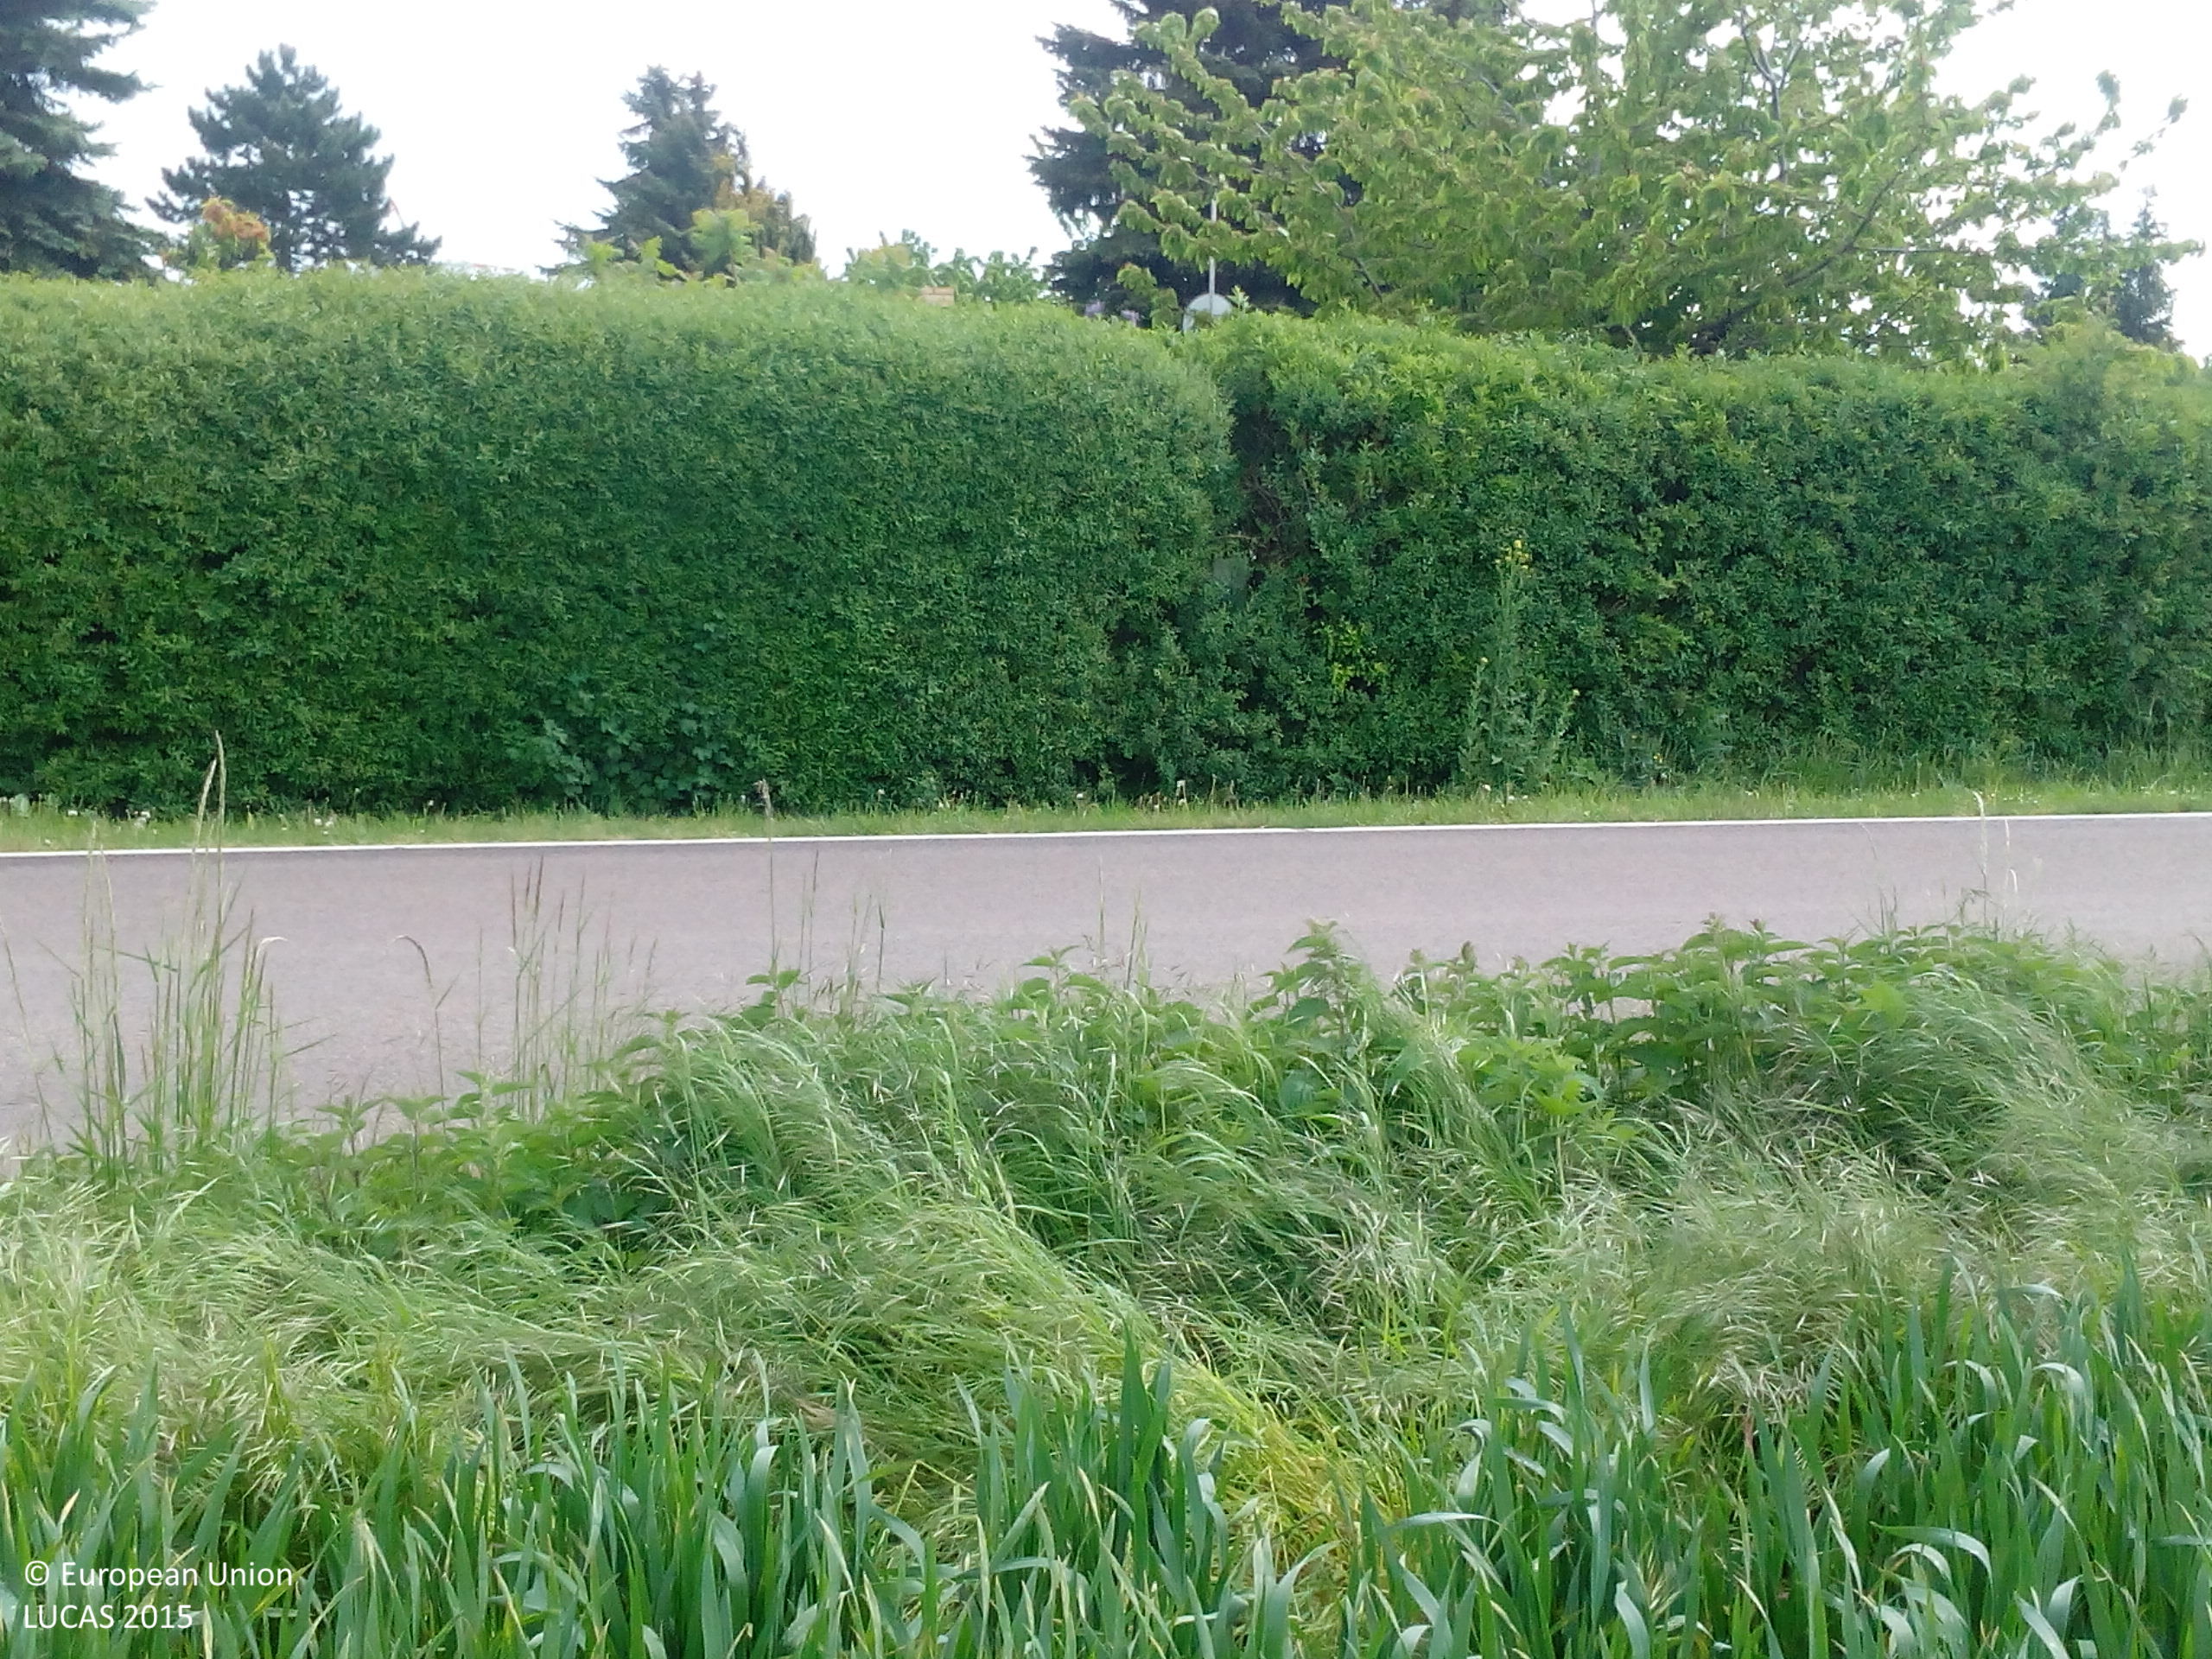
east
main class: Cropland
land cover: Common wheat
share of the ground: > 75 %
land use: Agriculture (excluding fallow land and kitchen gardens)
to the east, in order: Common wheat; Lines of trees; Artificial constructions in urban areas; Barley
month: May
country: DE
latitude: 51.5658
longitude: 12.2069
